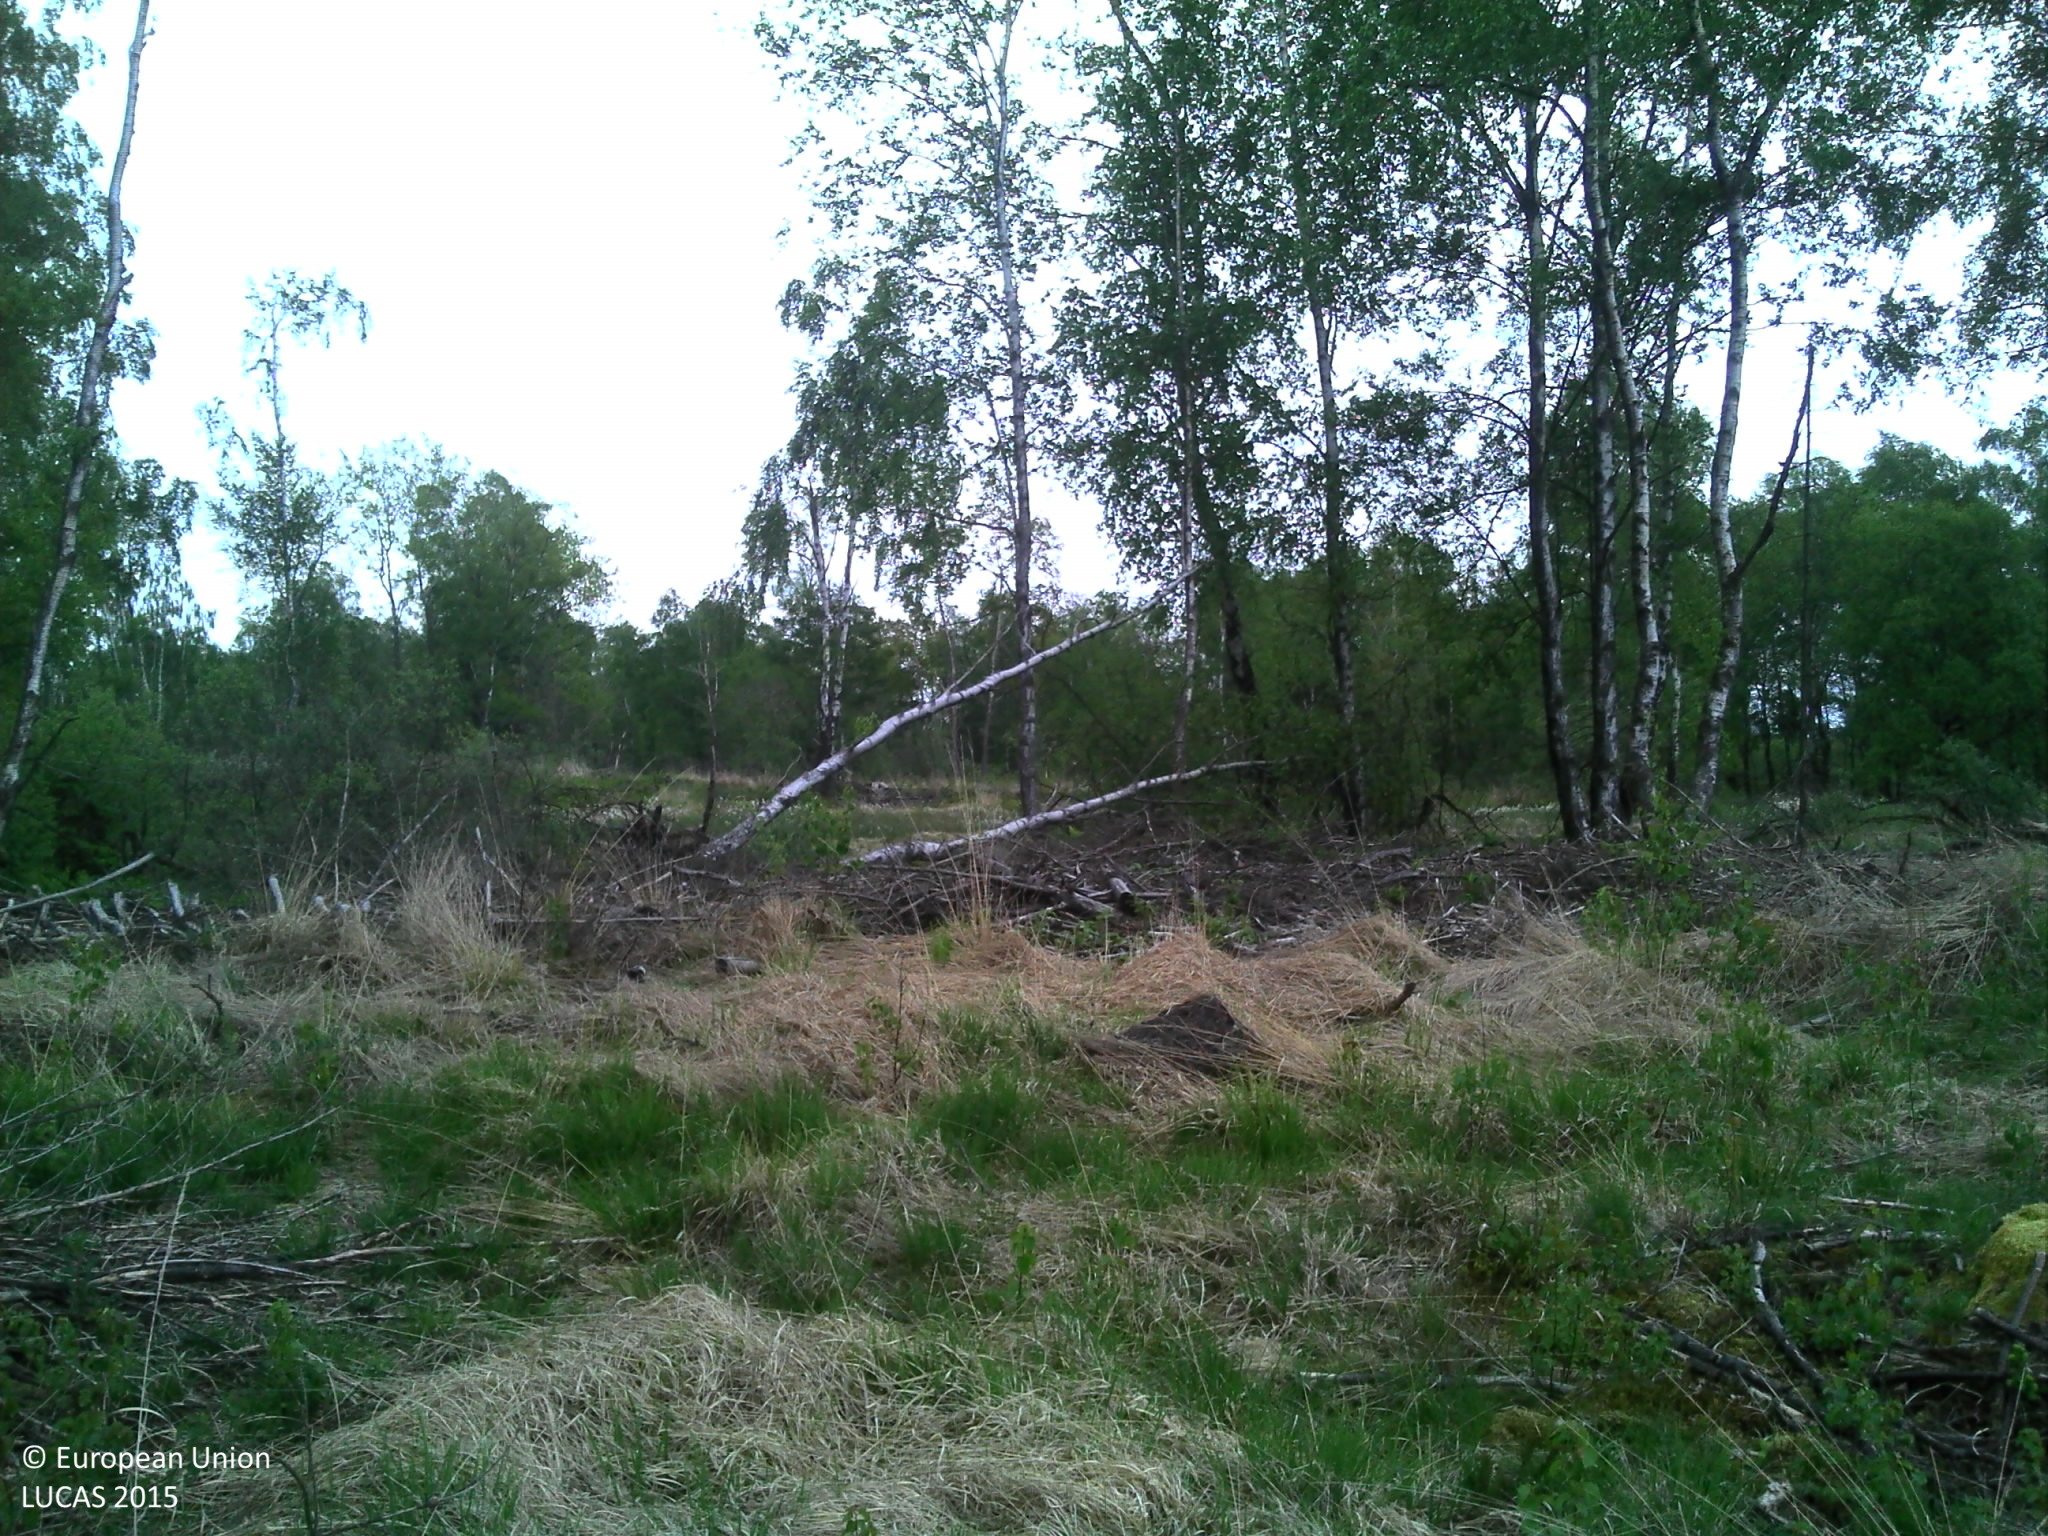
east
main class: Shrubland
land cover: Shrubland with sparse tree cover
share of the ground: > 75 %
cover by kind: herbaceous plants 80 %, shrubs 15 %, broadleaved forest trees 5 %
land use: Forestry
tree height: > 5 m
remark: Temporary flooded
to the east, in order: Shrubland with sparse tree cover; Peatbogs; Shrubland with sparse tree cover; Broadleaved woodland; Peatbogs; Broadleaved woodland; Shrubland with sparse tree cover; Broadleaved woodland; Ditches and canals; Grassland with sparse tree/shrub cover; Tracks; Grassland with sparse tree/shrub cover; Spruce dominated mixed woodland; Fences; Grassland without tree/shrub cover
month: May
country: BE
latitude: 50.6088
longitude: 6.2546
